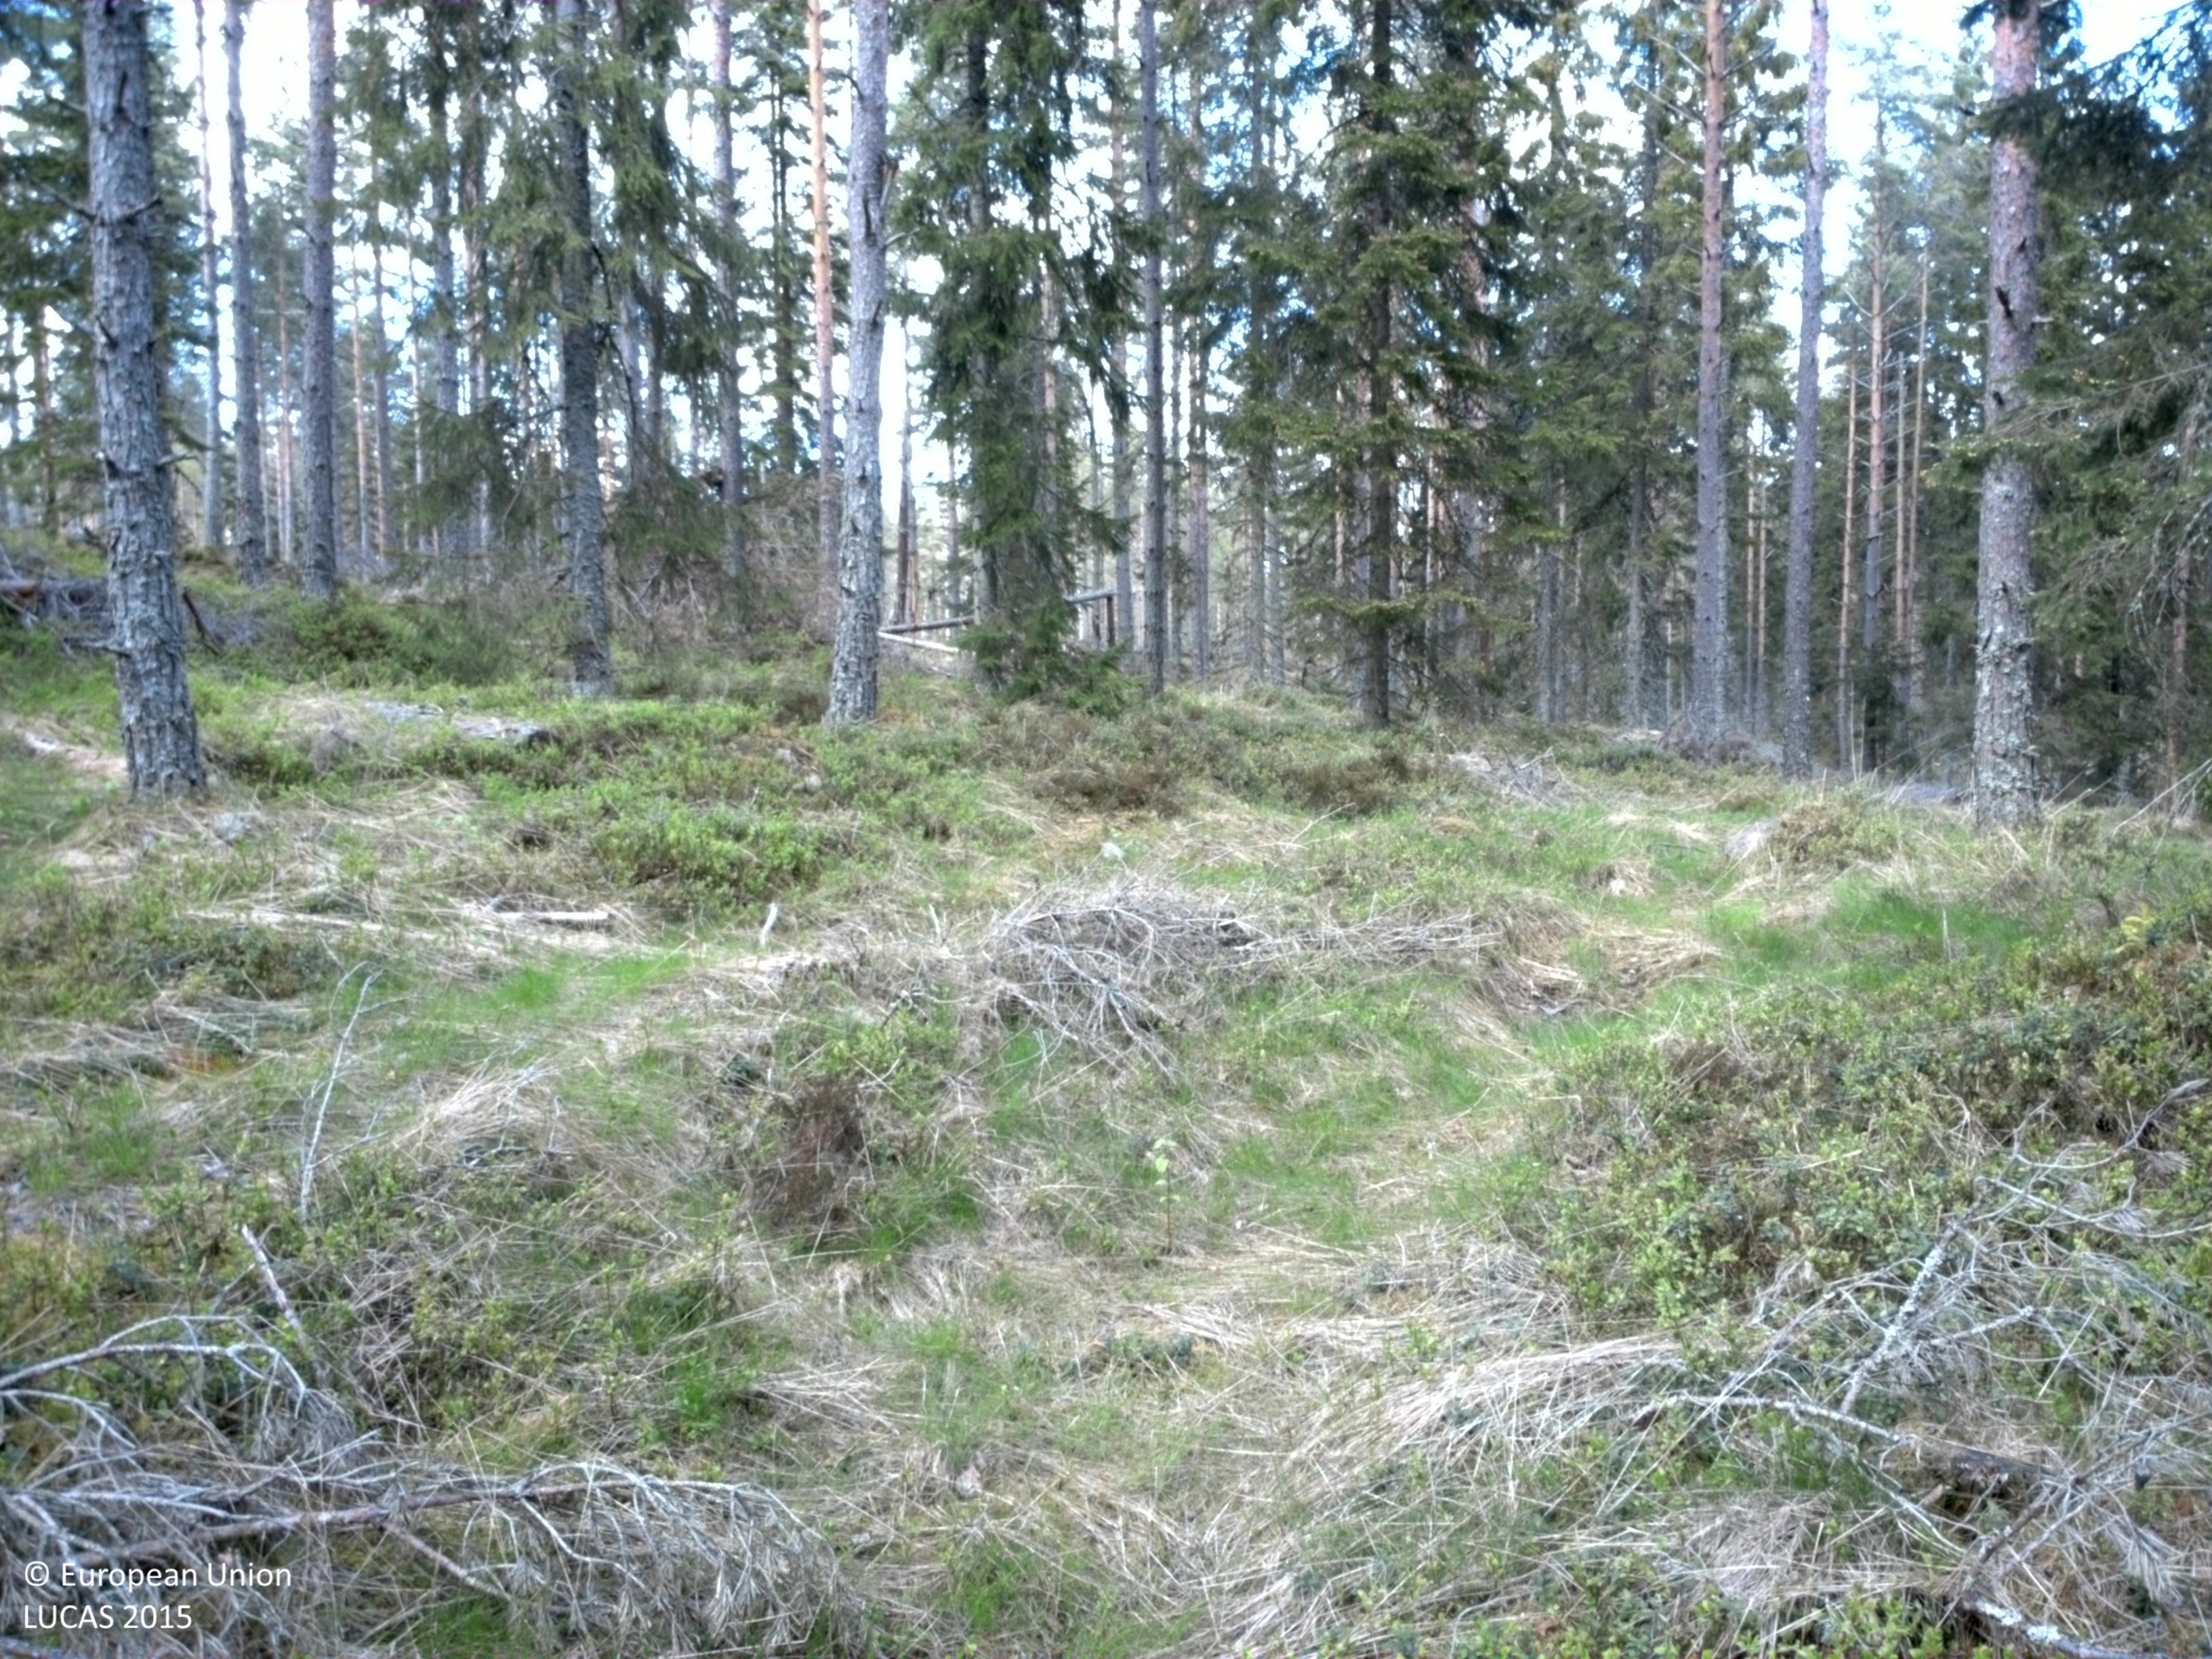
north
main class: Woodland
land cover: Spruce dominated coniferous woodland
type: boreal forest
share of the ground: > 75 %
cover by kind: coniferous forest trees 75 %, shrubs 10 %, broadleaved forest trees 5 %, herbaceous plants 5 %, lichens and mosses 5 %
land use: Forestry
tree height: > 5 m
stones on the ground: 25 - 50 %
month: May
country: SE
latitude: 59.4776
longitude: 12.3065
